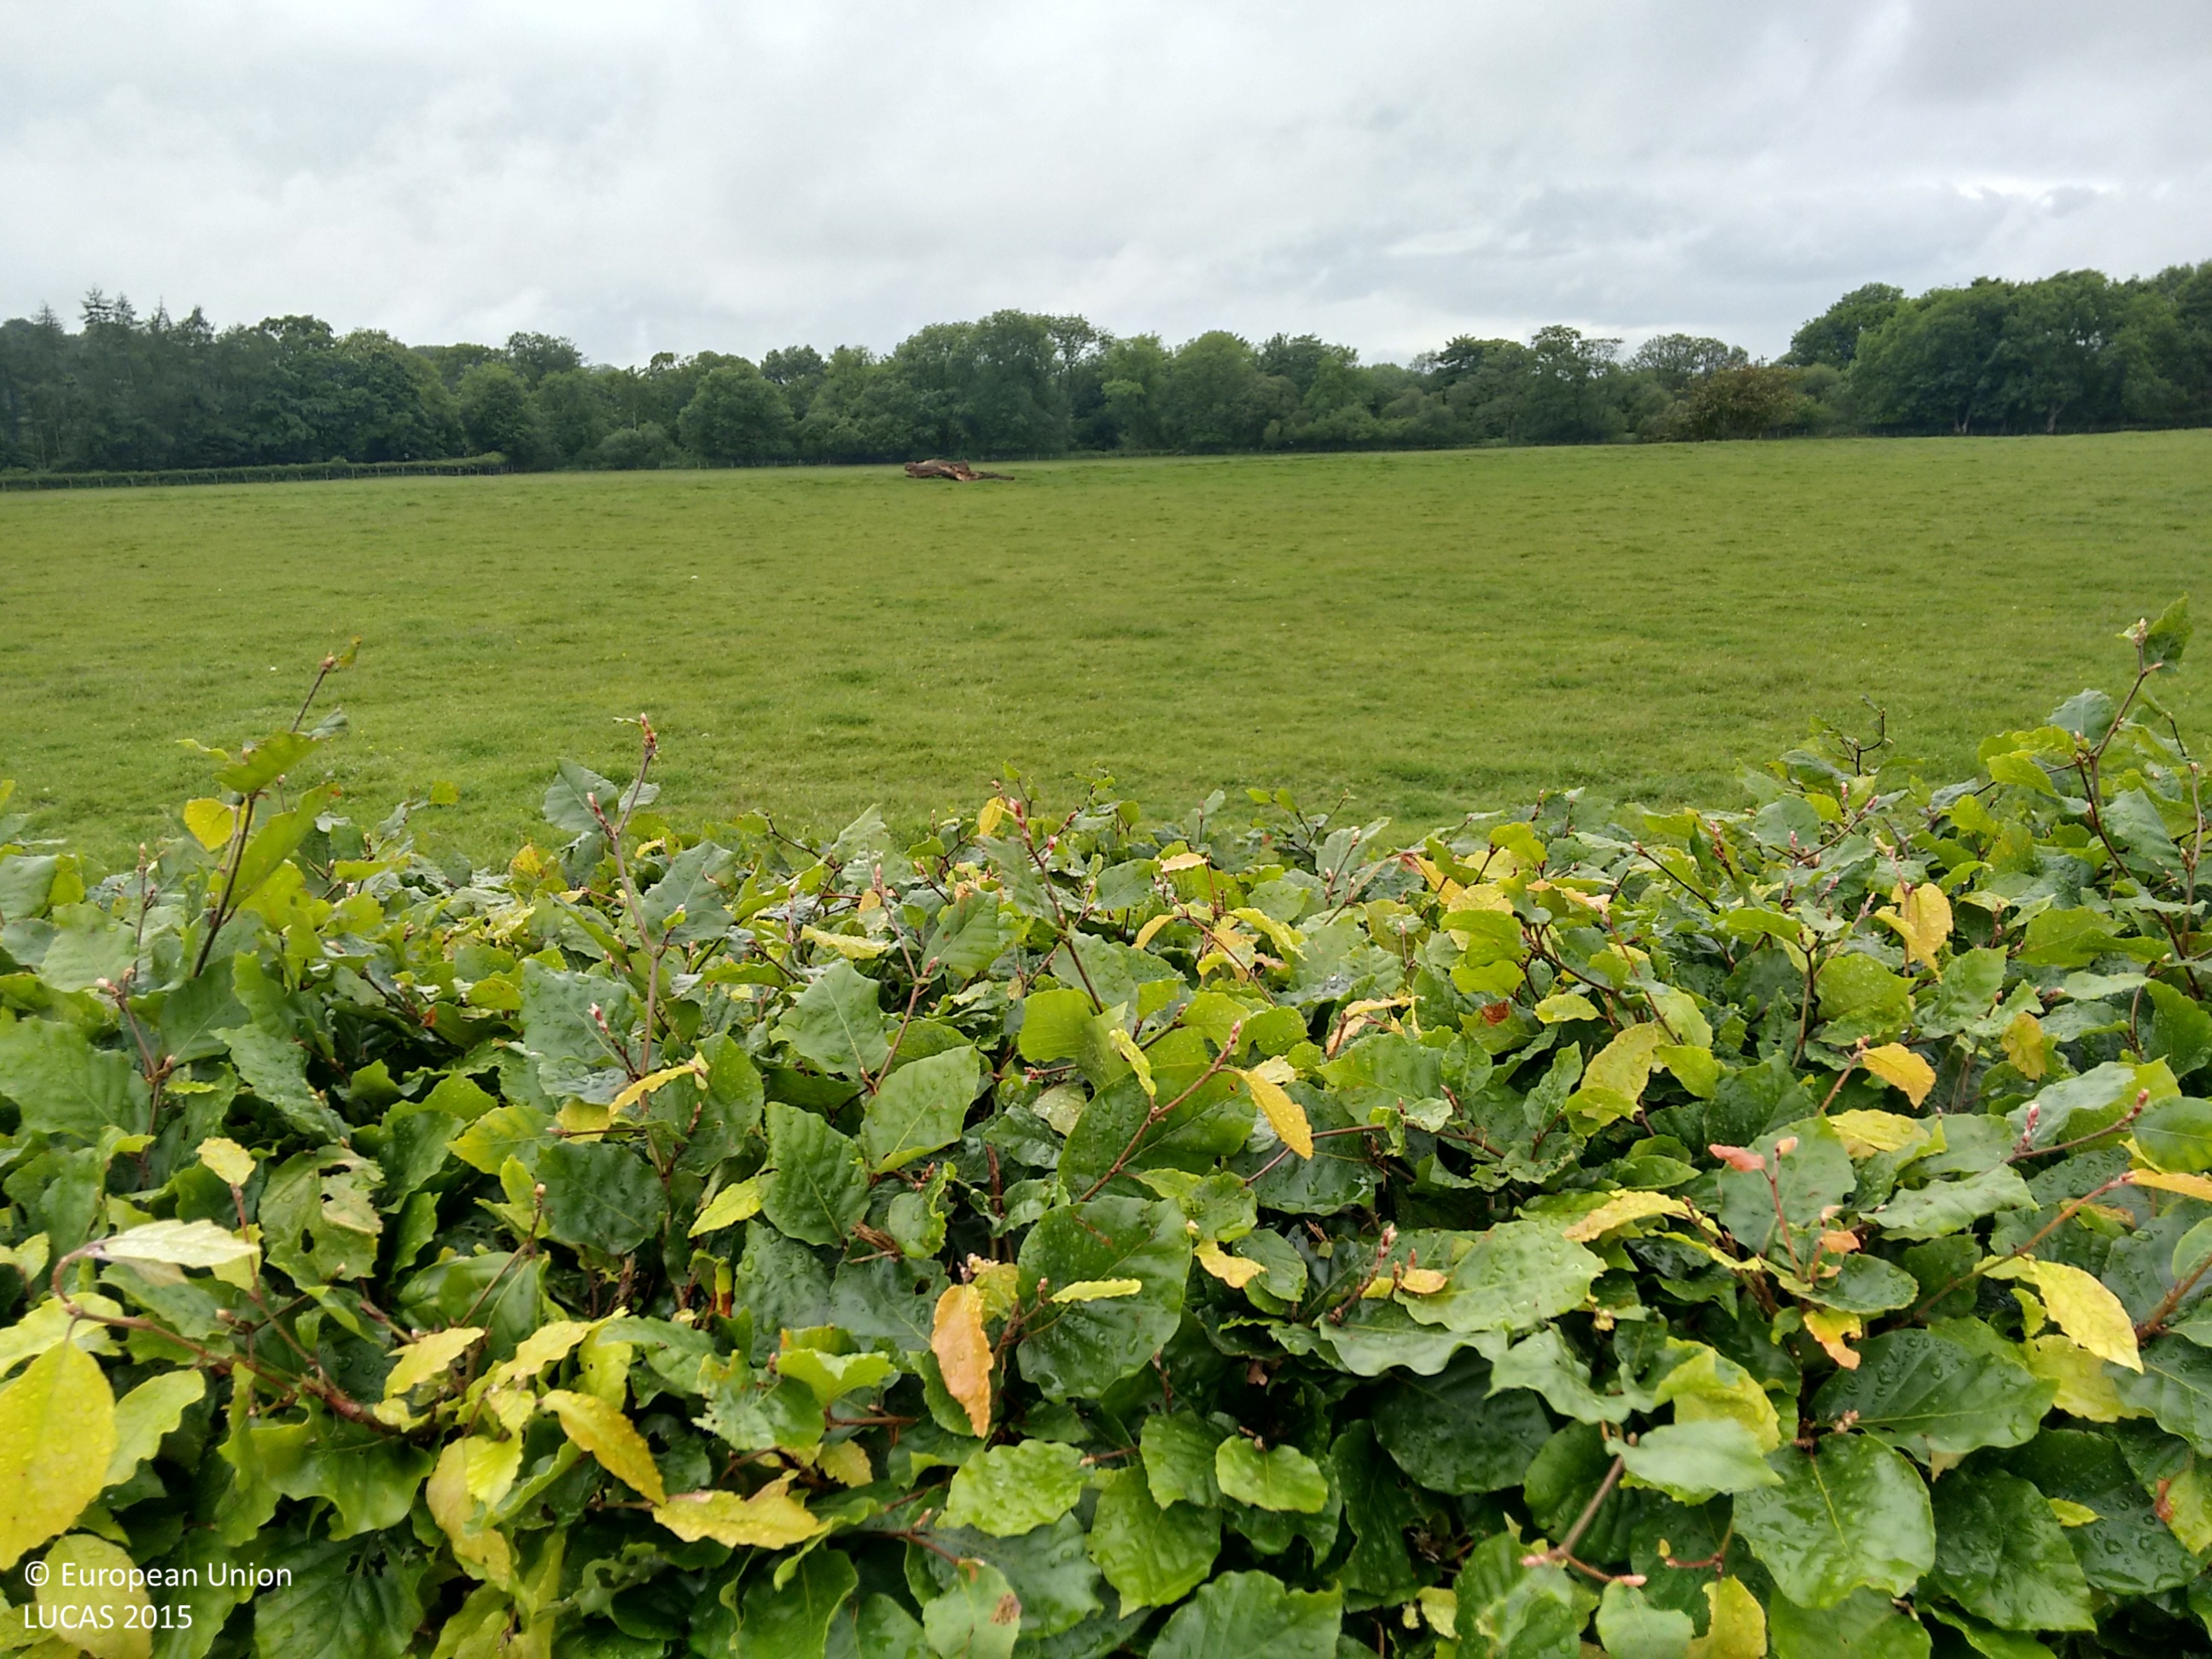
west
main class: Grassland
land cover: Grassland without tree/shrub cover
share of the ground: > 75 %
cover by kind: herbaceous plants 100 %
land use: Agriculture (excluding fallow land and kitchen gardens)
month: June
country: GB
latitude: 55.0496
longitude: -3.3348
